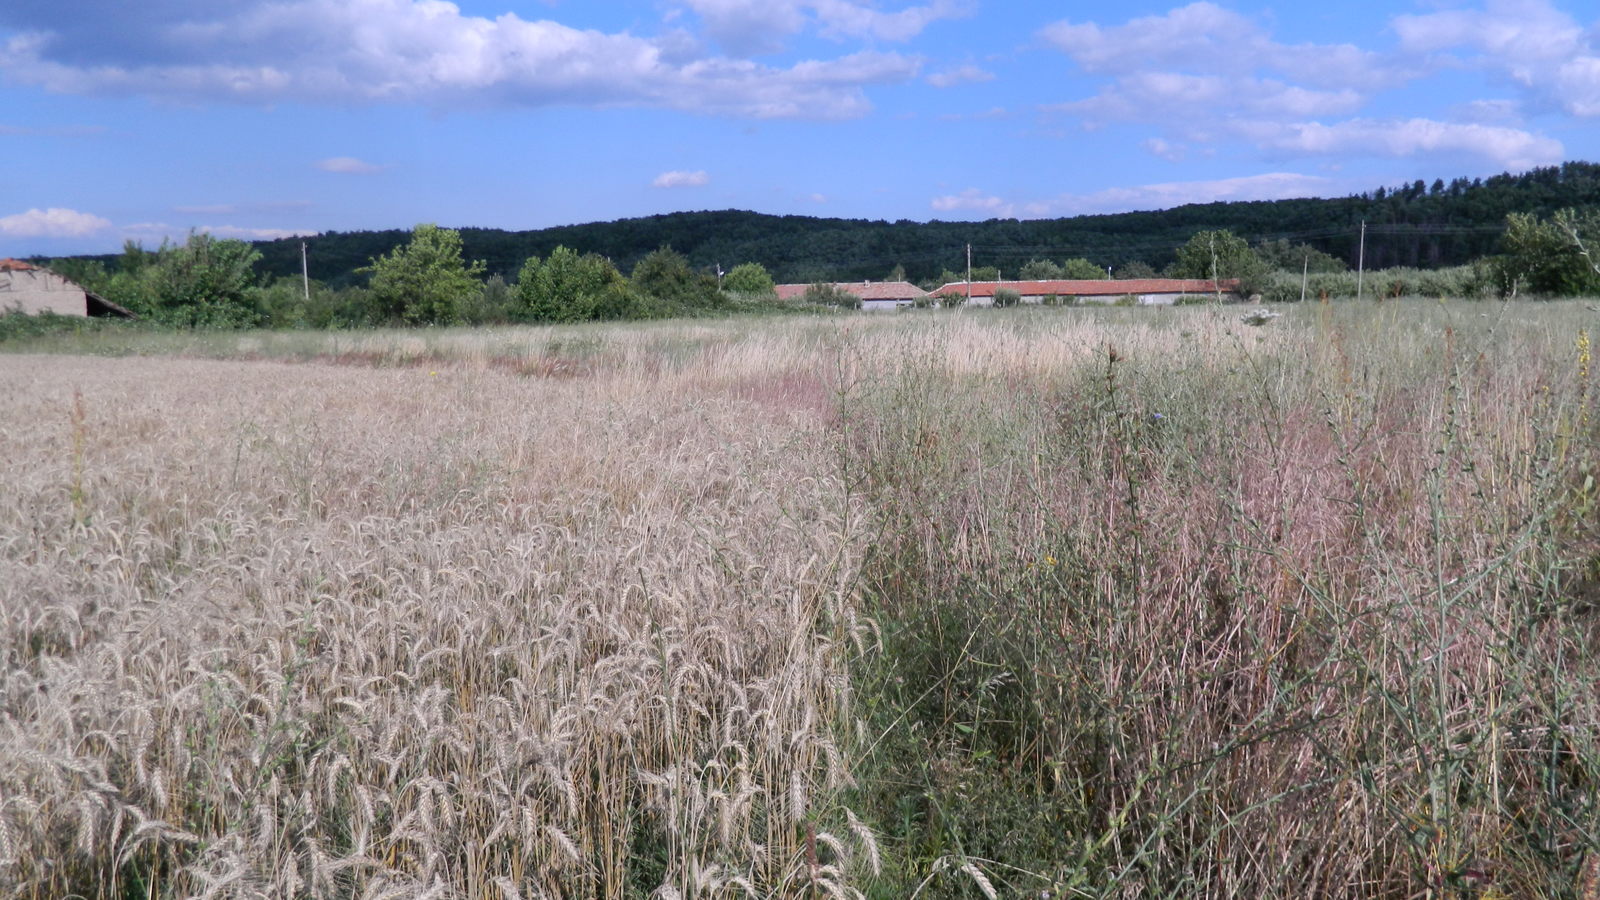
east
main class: Cropland
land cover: Common wheat
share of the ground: > 75 %
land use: Agriculture (excluding fallow land and kitchen gardens)
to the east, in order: Common wheat; Grass margins; Shrubland with sparse tree cover; Electric lines; Shrubland with sparse tree cover; Artificial constructions in urban areas; Other fruit trees and berries; Fences; Grassland without tree/shrub cover; Lines of trees; Paved roads, cycling and walking lanes; Grass margins; Common wheat
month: July
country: BG
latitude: 41.9406
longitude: 25.0716
